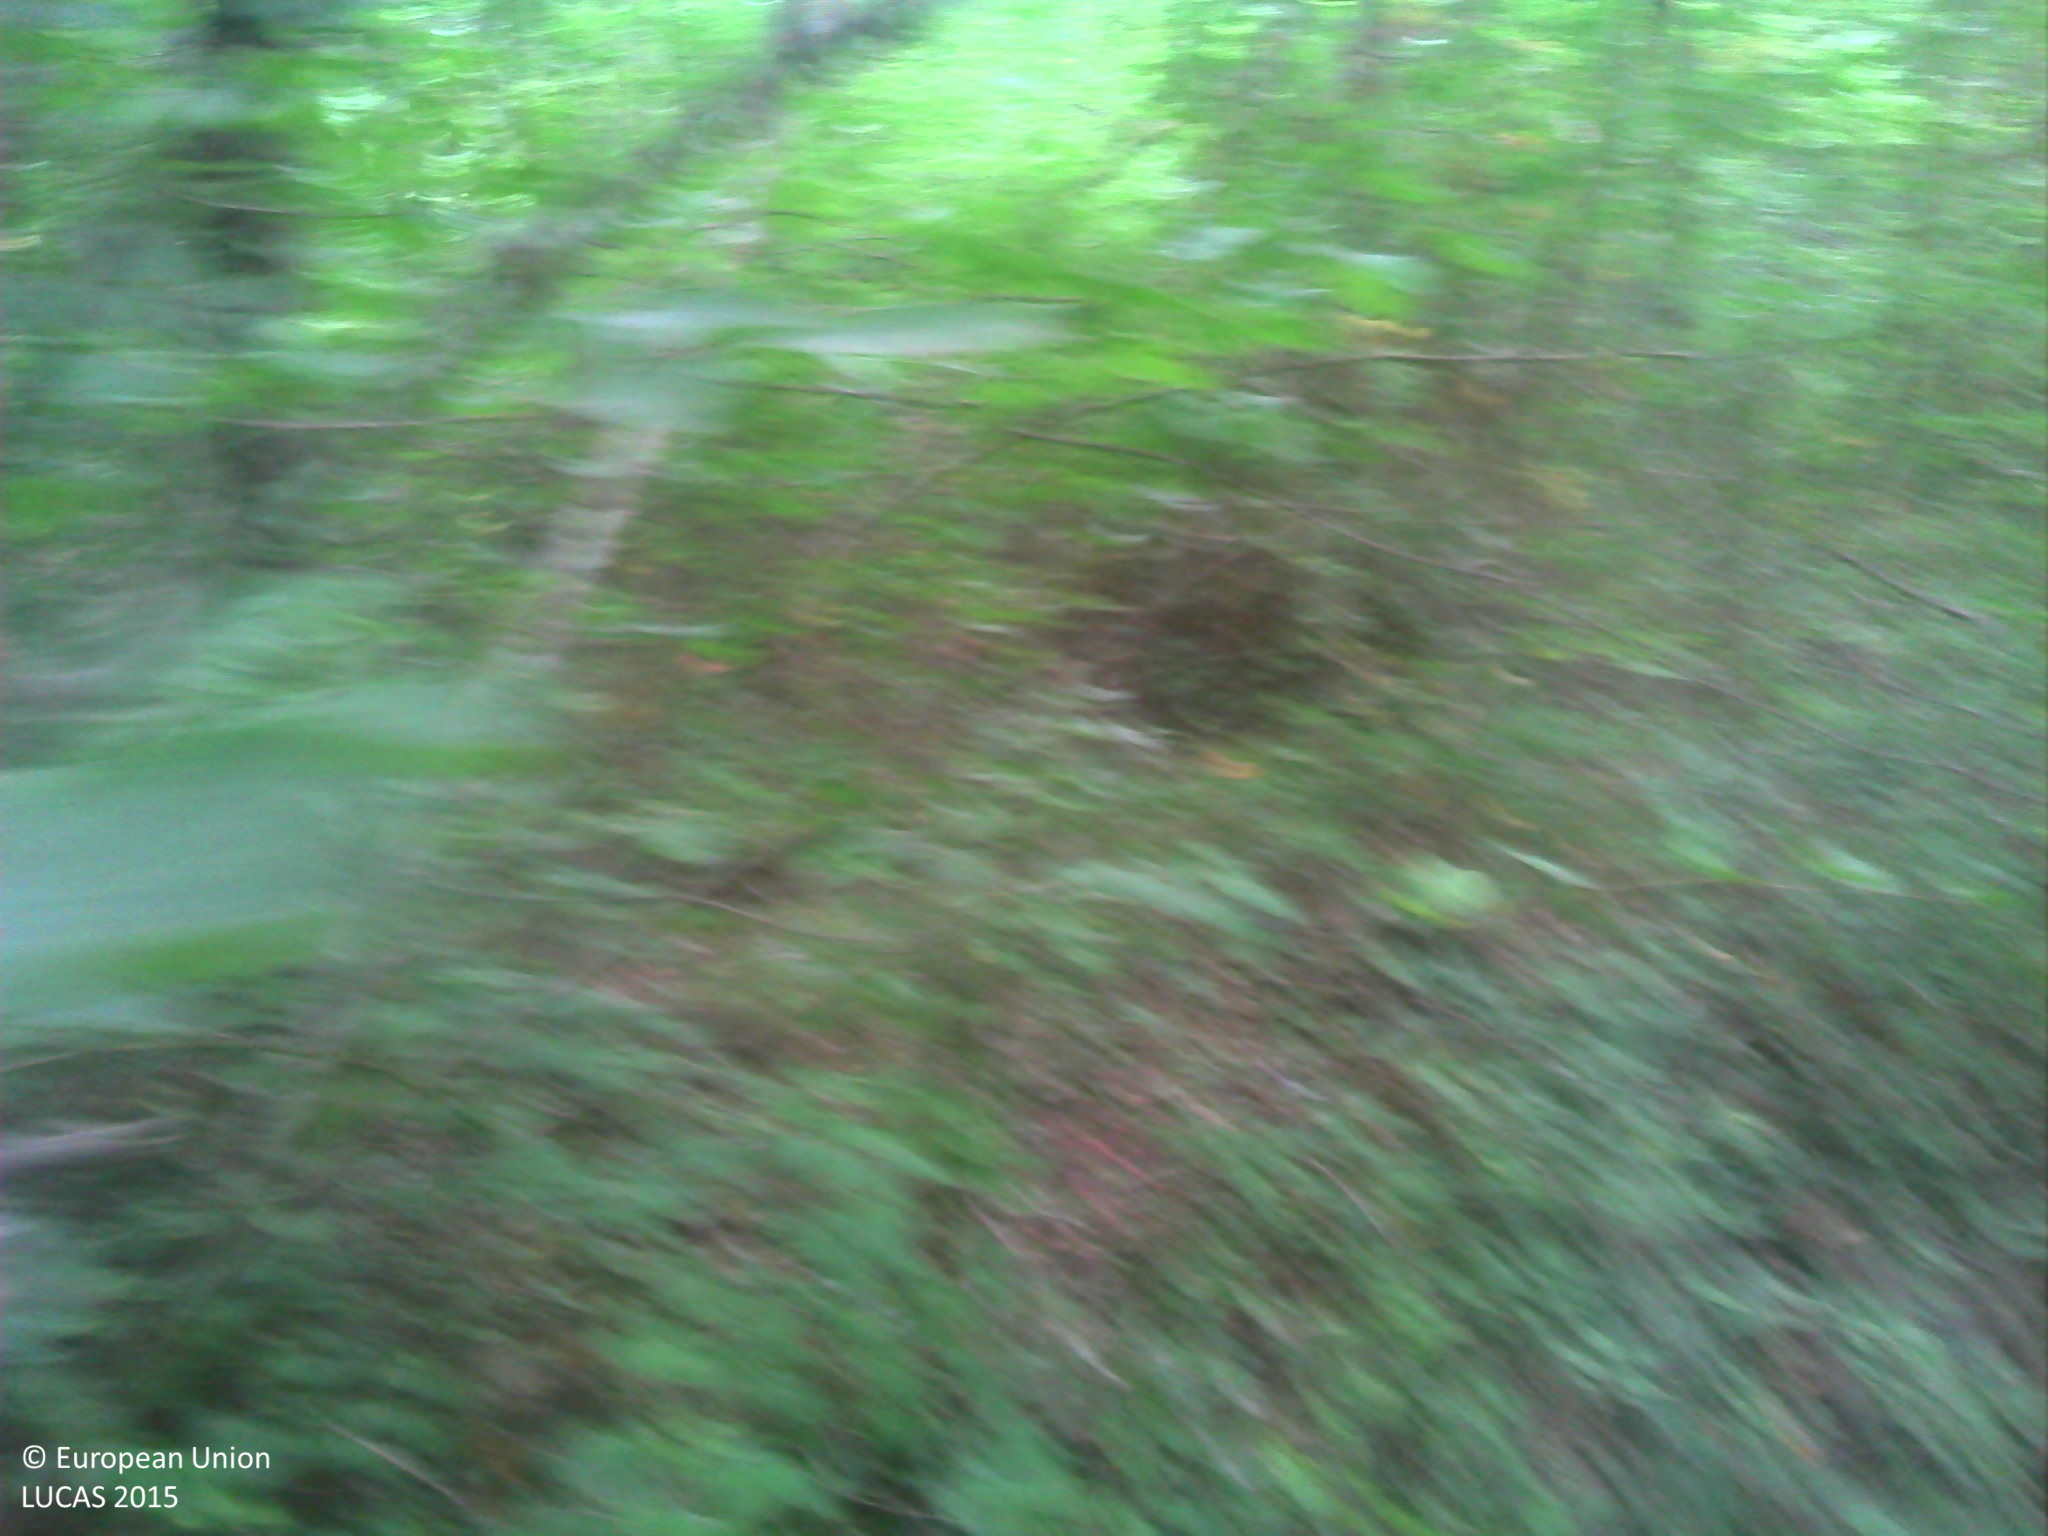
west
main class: Woodland
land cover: Broadleaved woodland
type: acidophilous oak and oak-birch forest
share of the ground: > 75 %
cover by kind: broadleaved forest trees 60 %, shrubs 30 %, herbaceous plants 10 %
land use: Forestry
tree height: > 5 m
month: July
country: FR
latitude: 43.2910
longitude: 1.4632
